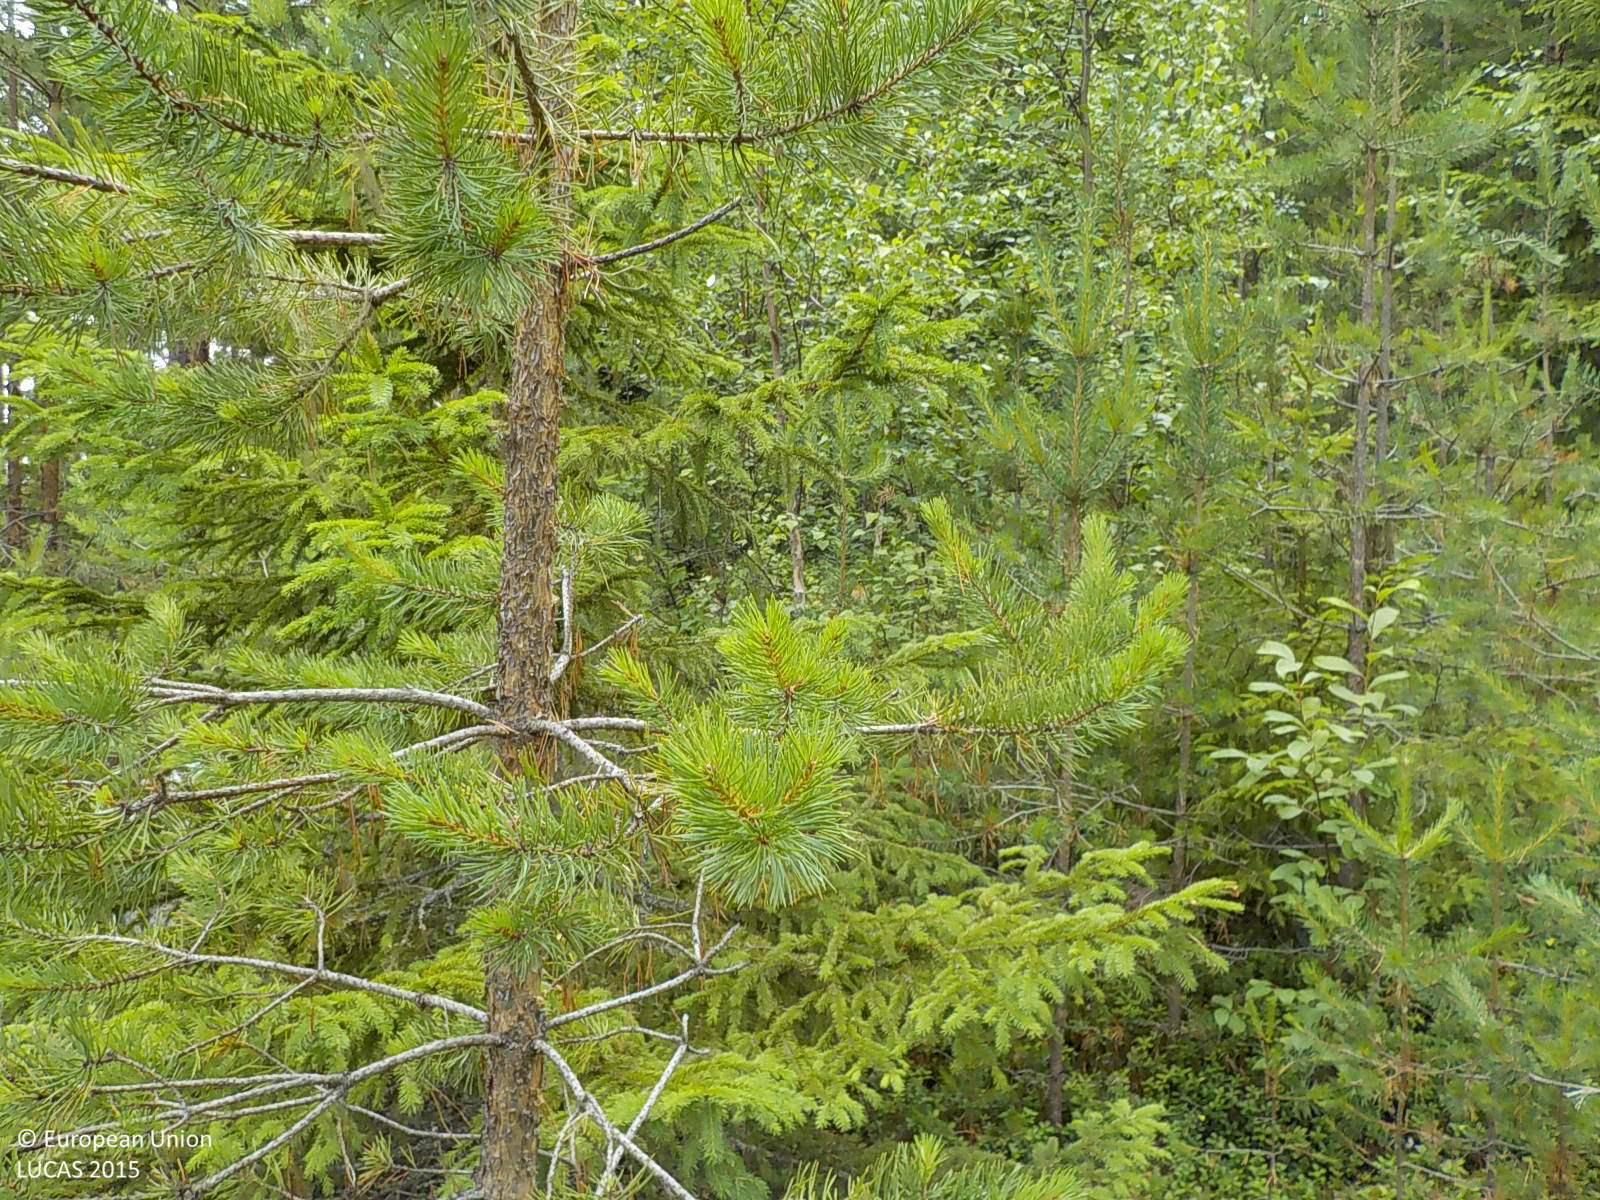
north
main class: Woodland
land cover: Pine dominated coniferous woodland
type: boreal forest
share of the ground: > 75 %
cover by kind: coniferous forest trees 80 %, lichens and mosses 10 %, consolidated bare surface 10 %
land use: Forestry
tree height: > 5 m
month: July
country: SE
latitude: 63.2534
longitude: 17.2448
